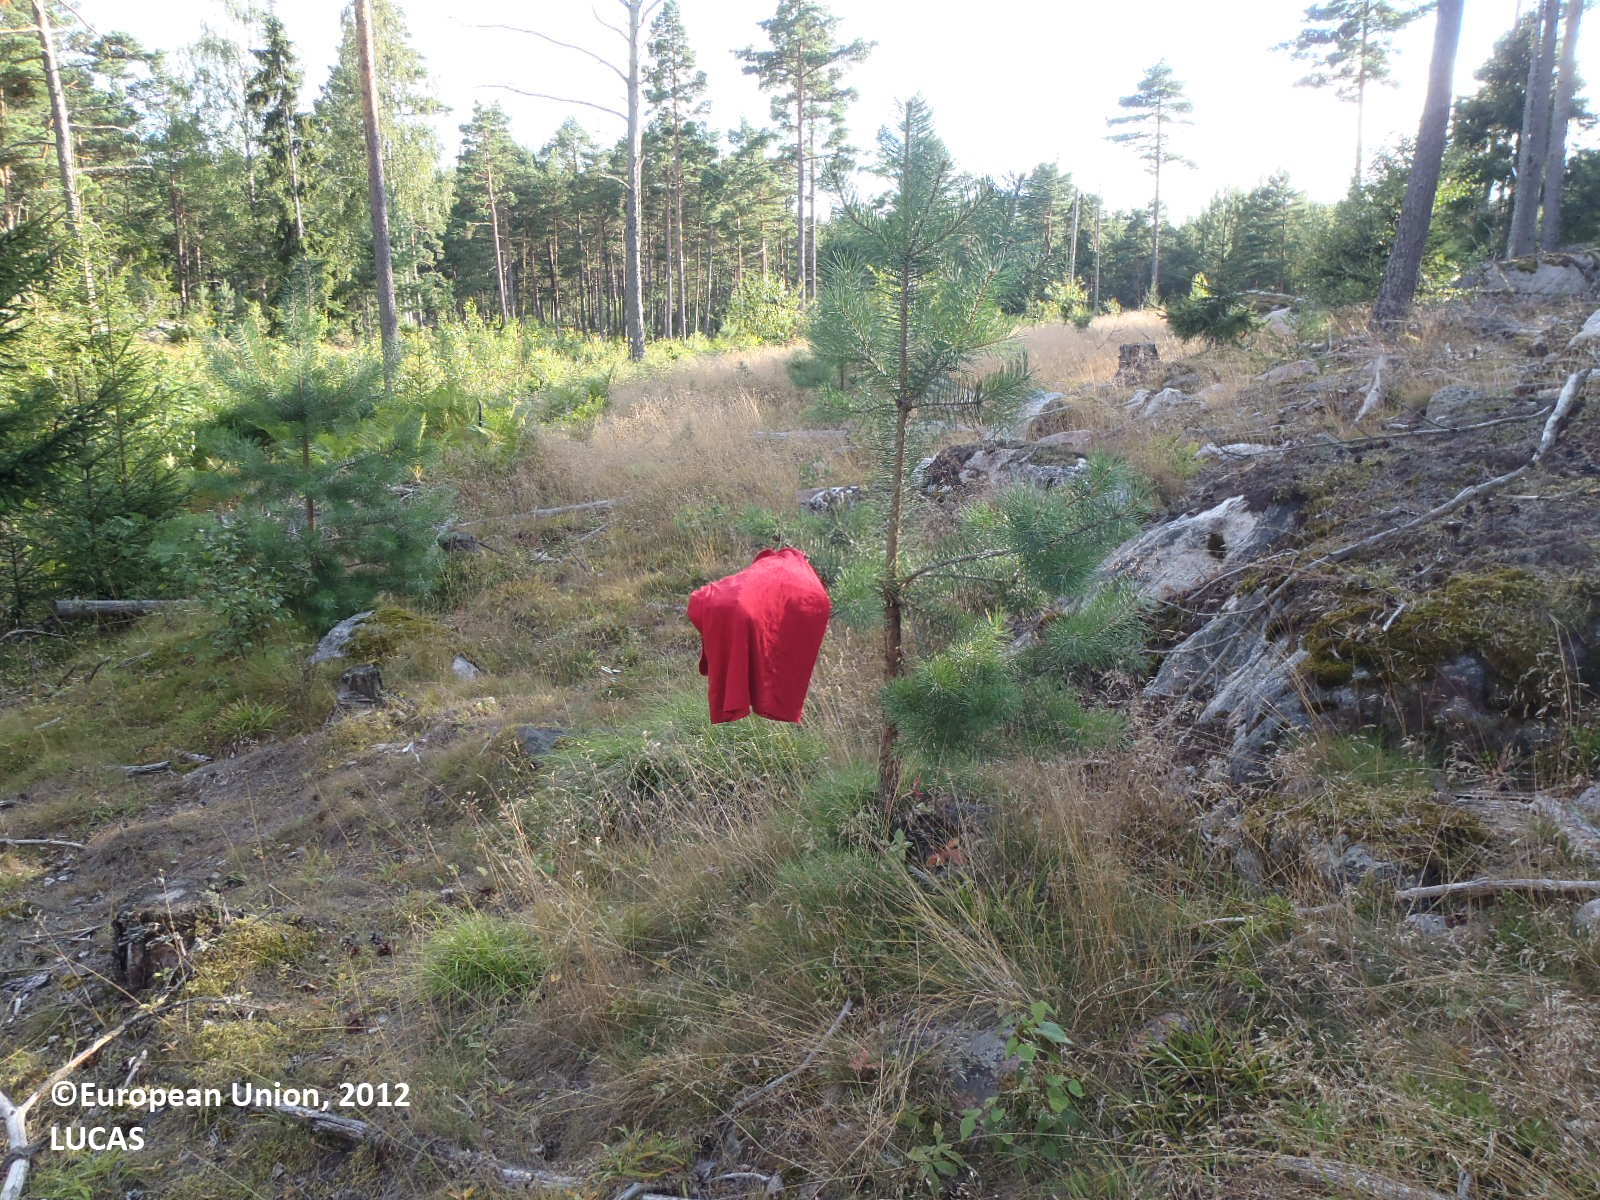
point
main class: Woodland
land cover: Pine dominated mixed woodland
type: boreal forest
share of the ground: 10 - 25 %
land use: Forestry
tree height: > 5 m
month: August
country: FI
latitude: 60.1257
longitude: 21.5242
